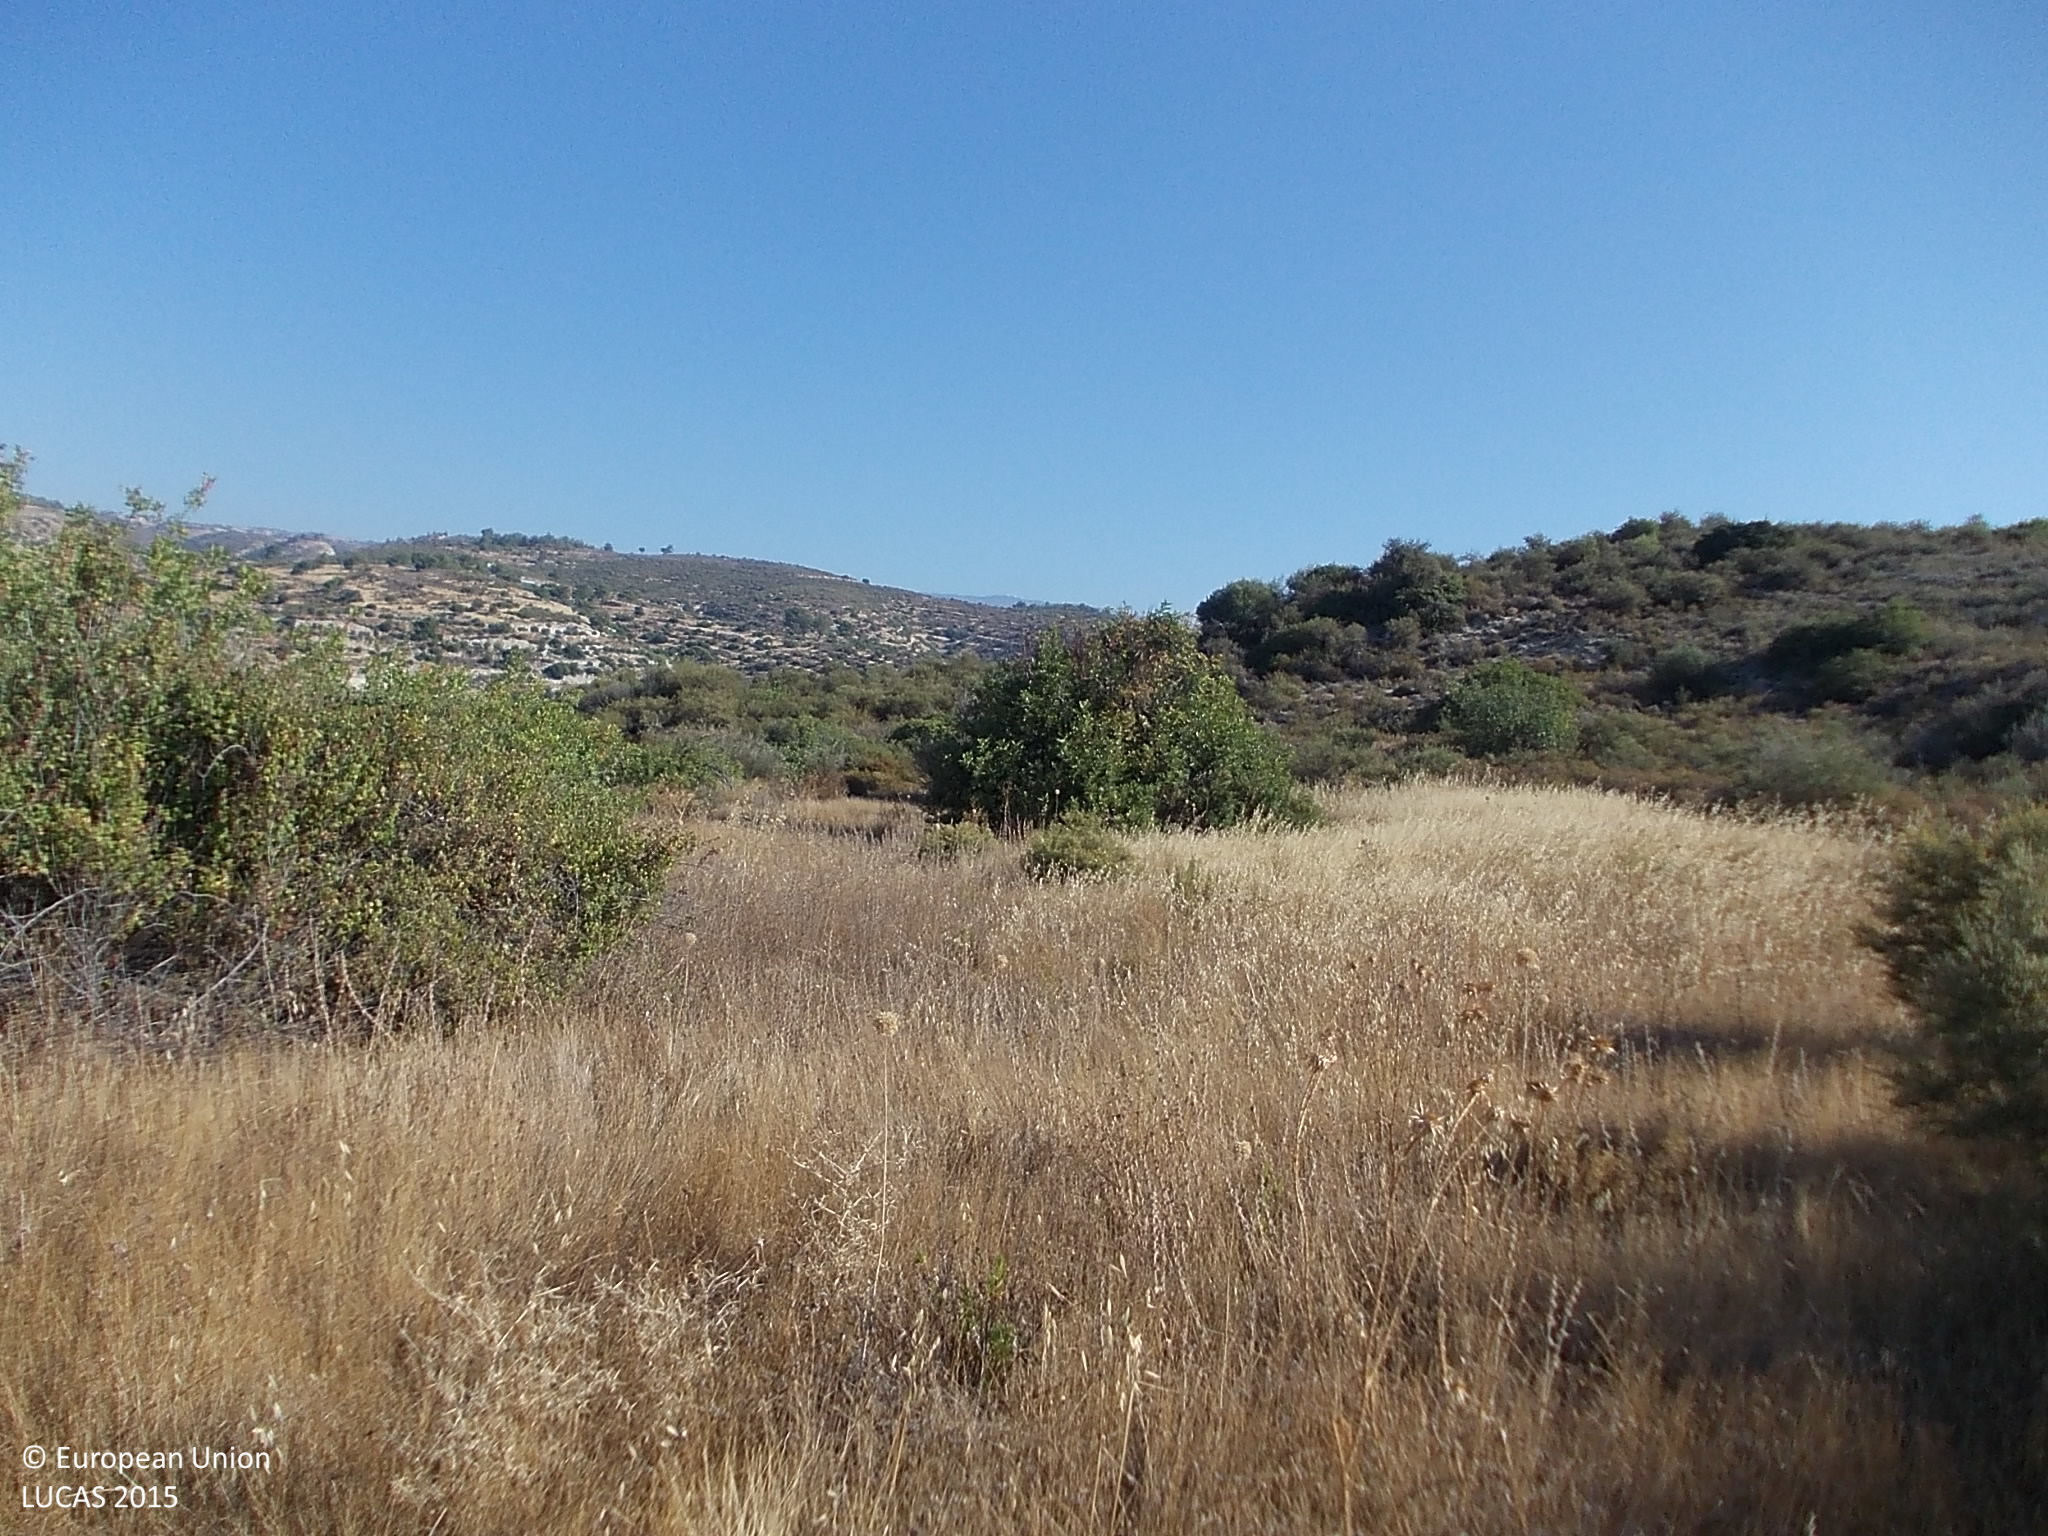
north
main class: Grassland
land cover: Grassland with sparse tree/shrub cover
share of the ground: > 75 %
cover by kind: herbaceous plants 90 %, coniferous forest trees 5 %, shrubs 5 %
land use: Semi-natural and natural areas not in use
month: August
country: CY
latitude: 34.7638
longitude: 32.8979
